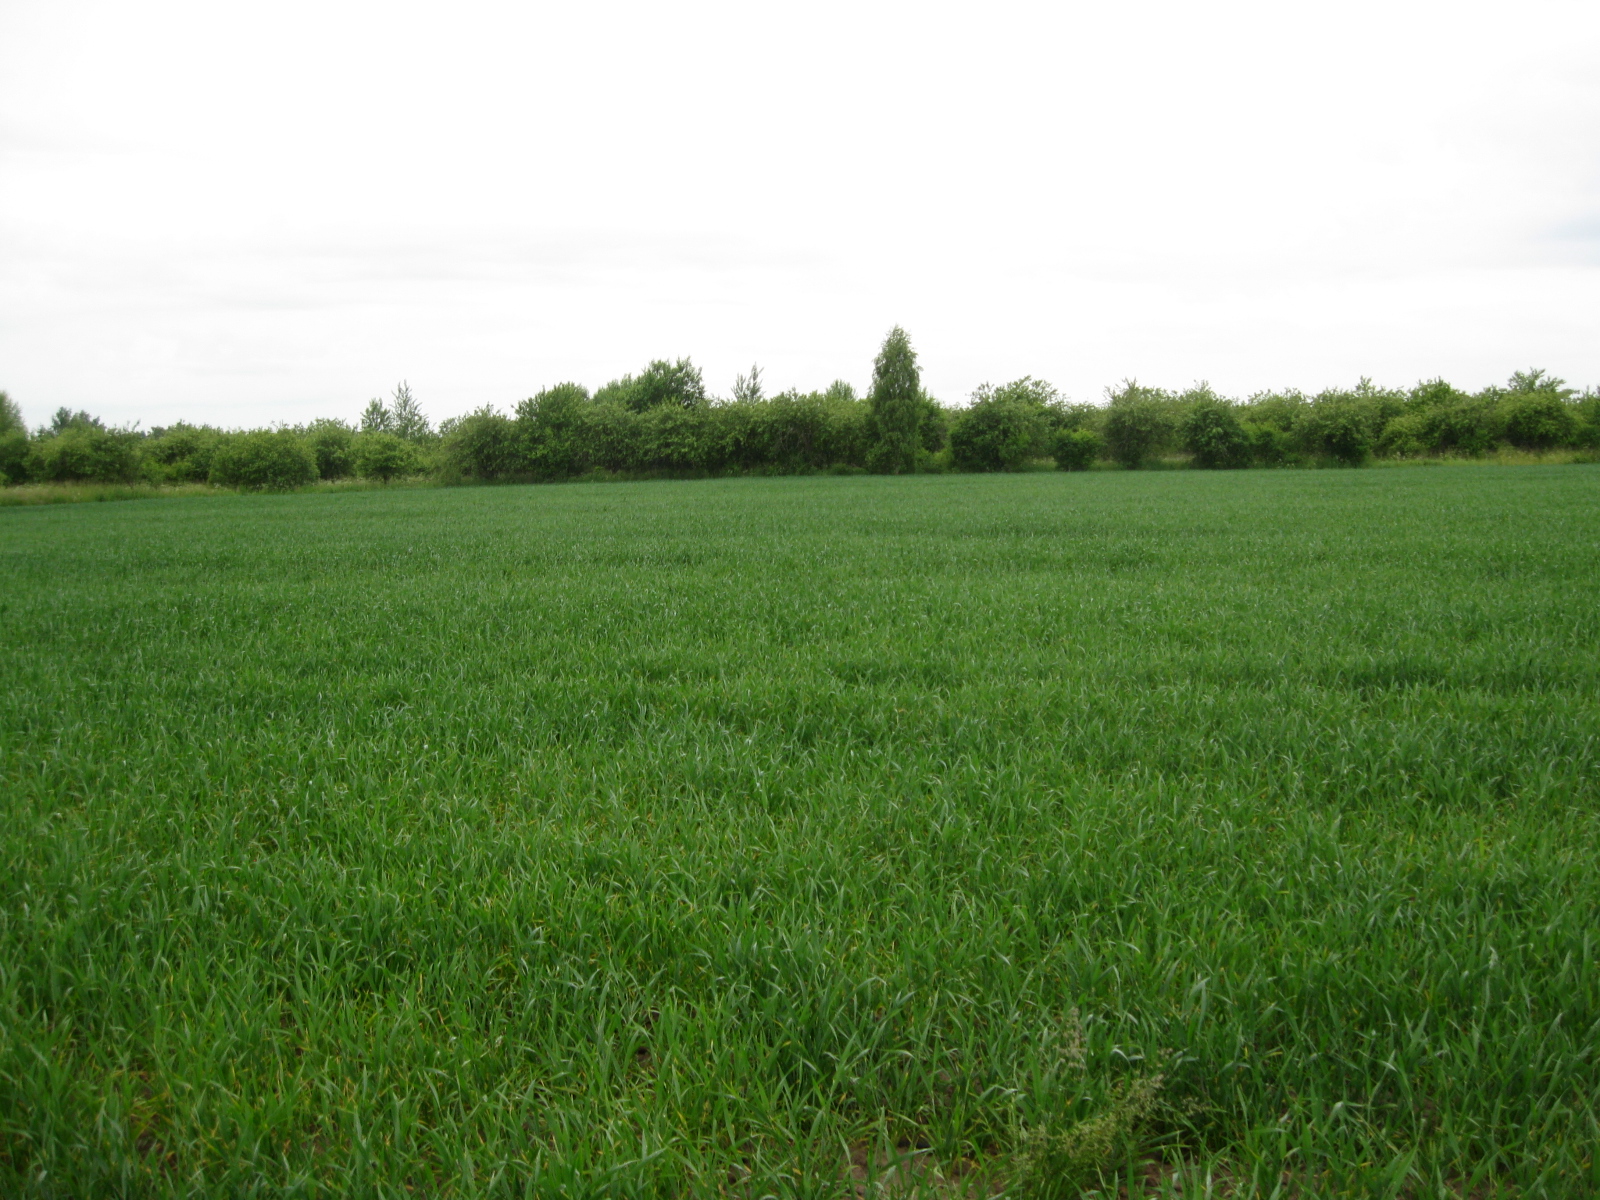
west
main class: Cropland
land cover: Common wheat
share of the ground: > 75 %
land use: Agriculture (excluding fallow land and kitchen gardens)
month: June
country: LT
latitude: 55.1684
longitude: 24.0797
